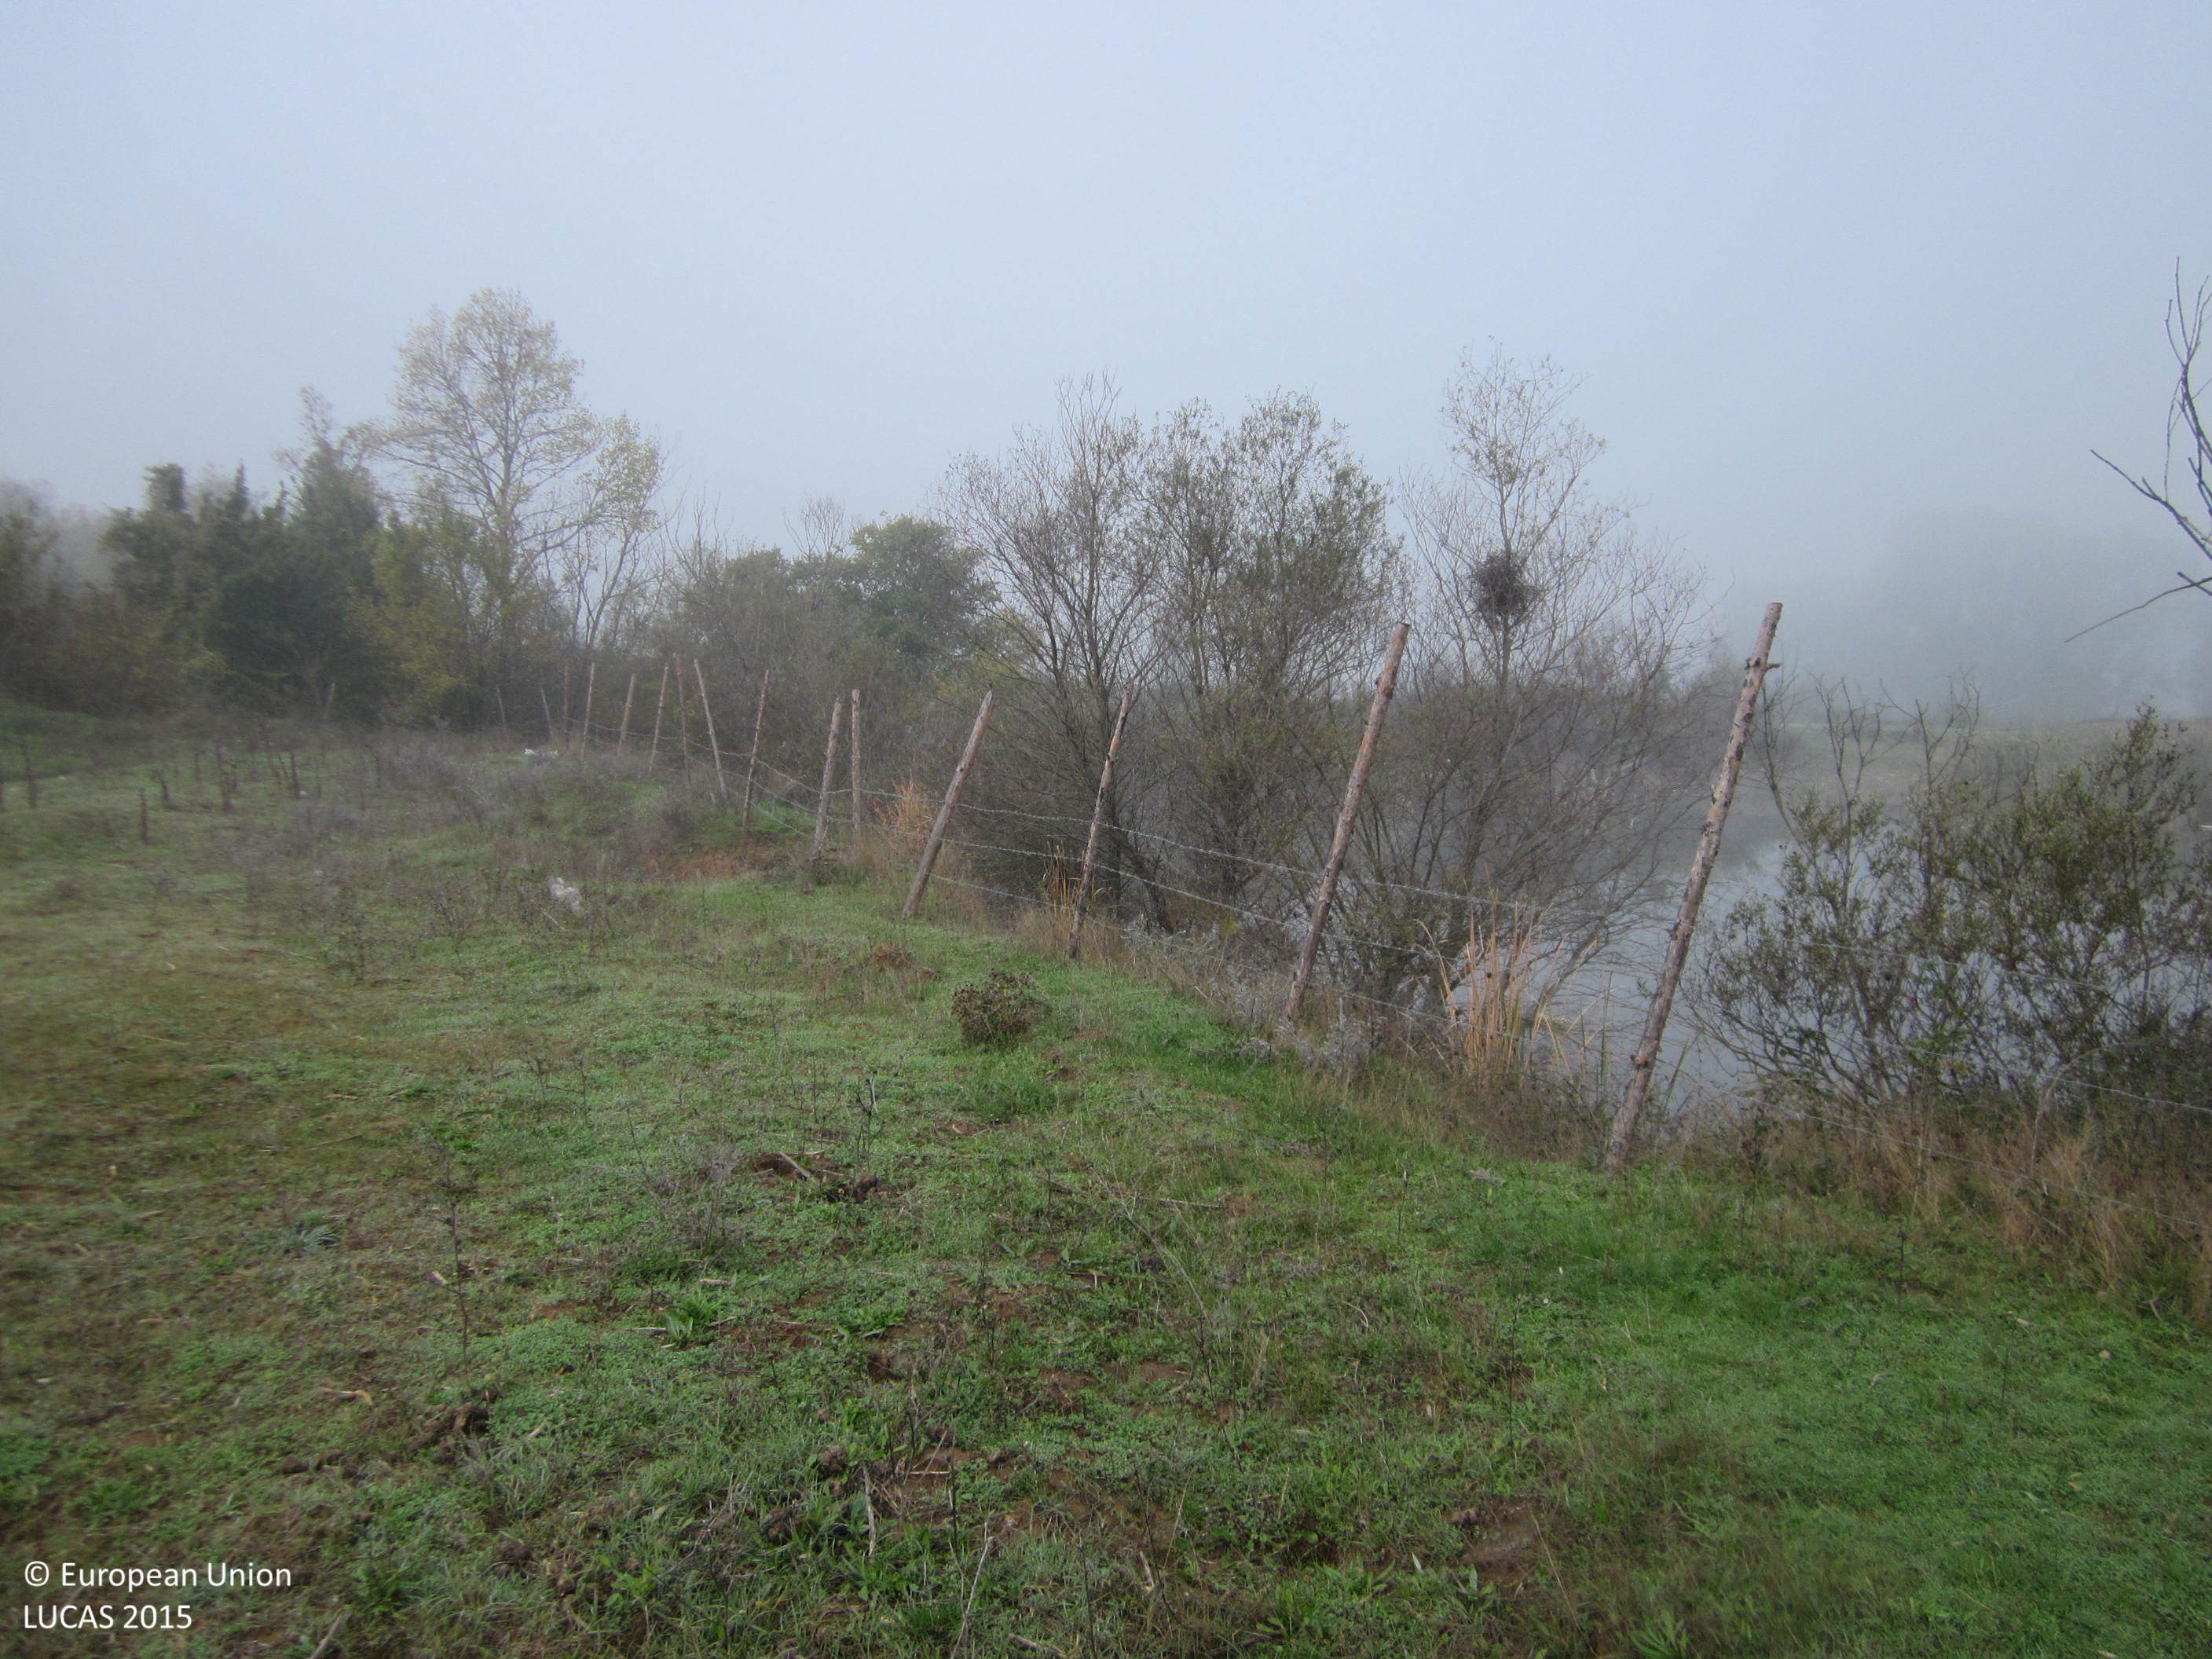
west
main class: Grassland
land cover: Grassland without tree/shrub cover
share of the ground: > 75 %
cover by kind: herbaceous plants 100 %
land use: Agriculture (excluding fallow land and kitchen gardens)
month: October
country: BG
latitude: 41.4675
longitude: 25.6373
